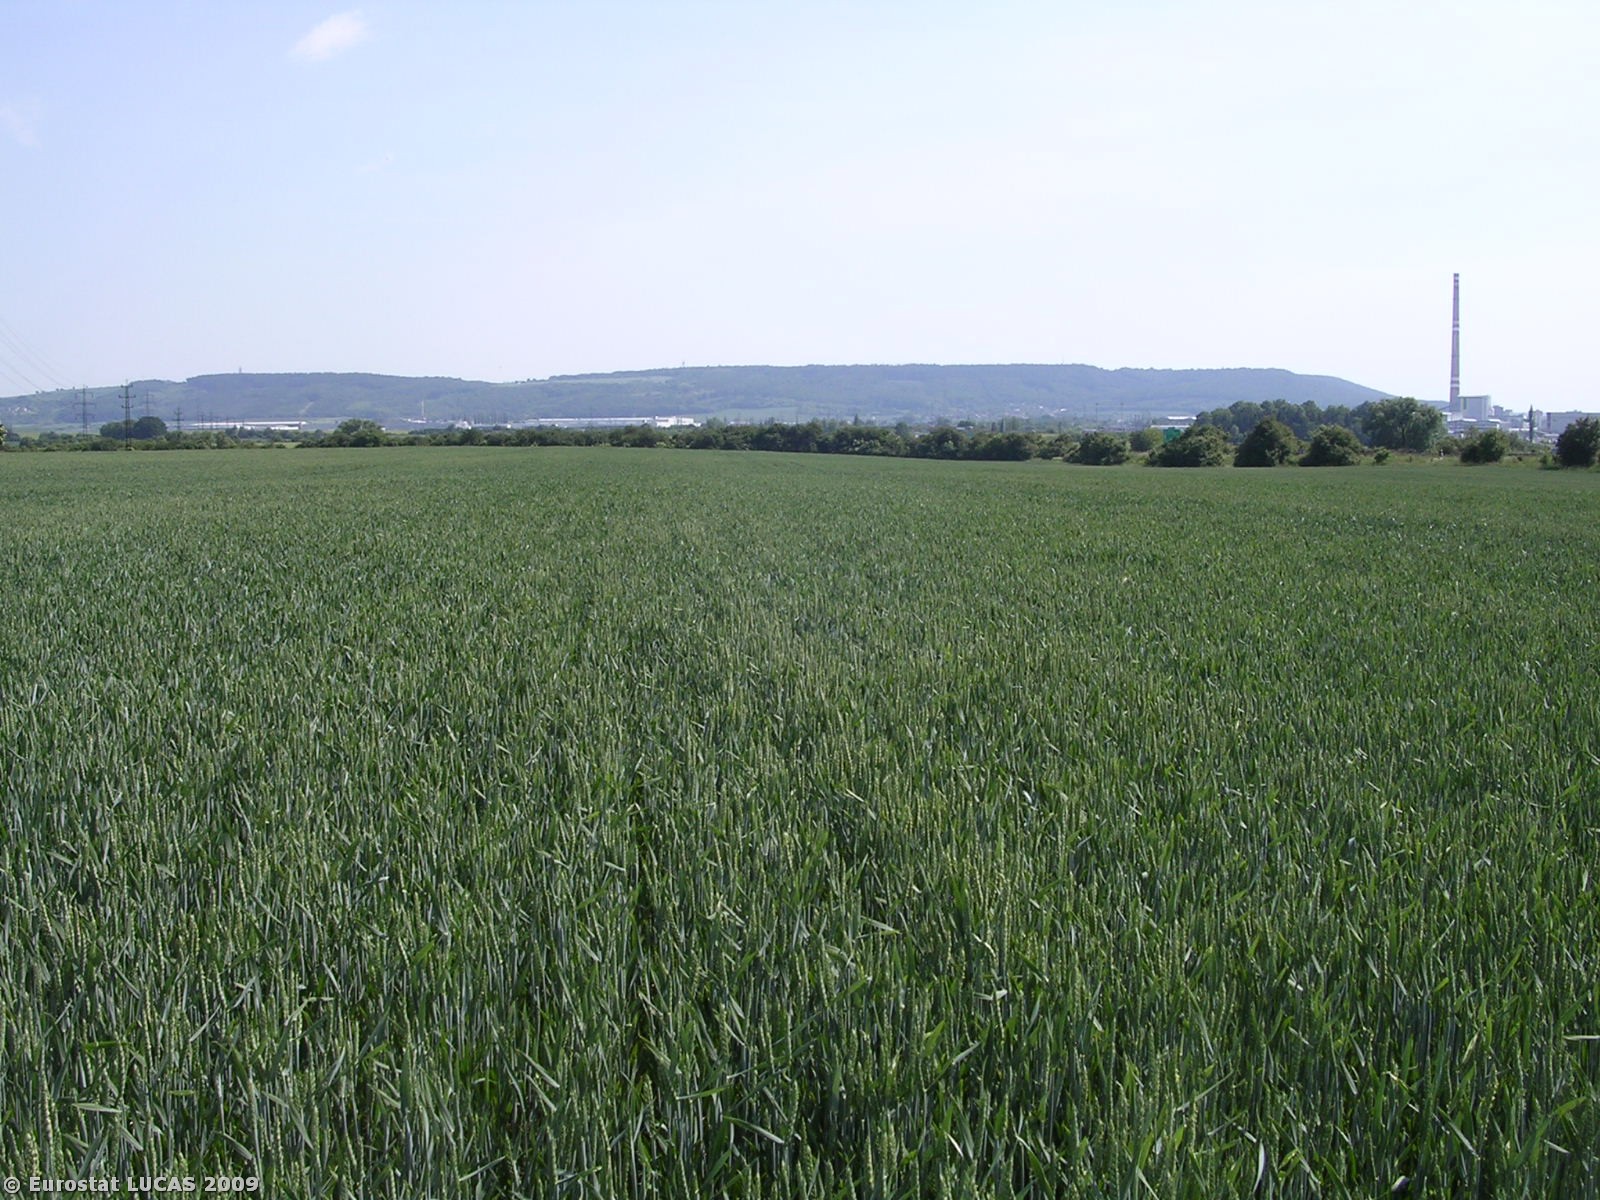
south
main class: Cropland
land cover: Common wheat
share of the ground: > 75 %
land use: Agriculture (excluding fallow land and kitchen gardens)
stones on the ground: < 10 %
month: May
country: CZ
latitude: 50.4373
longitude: 14.9447
